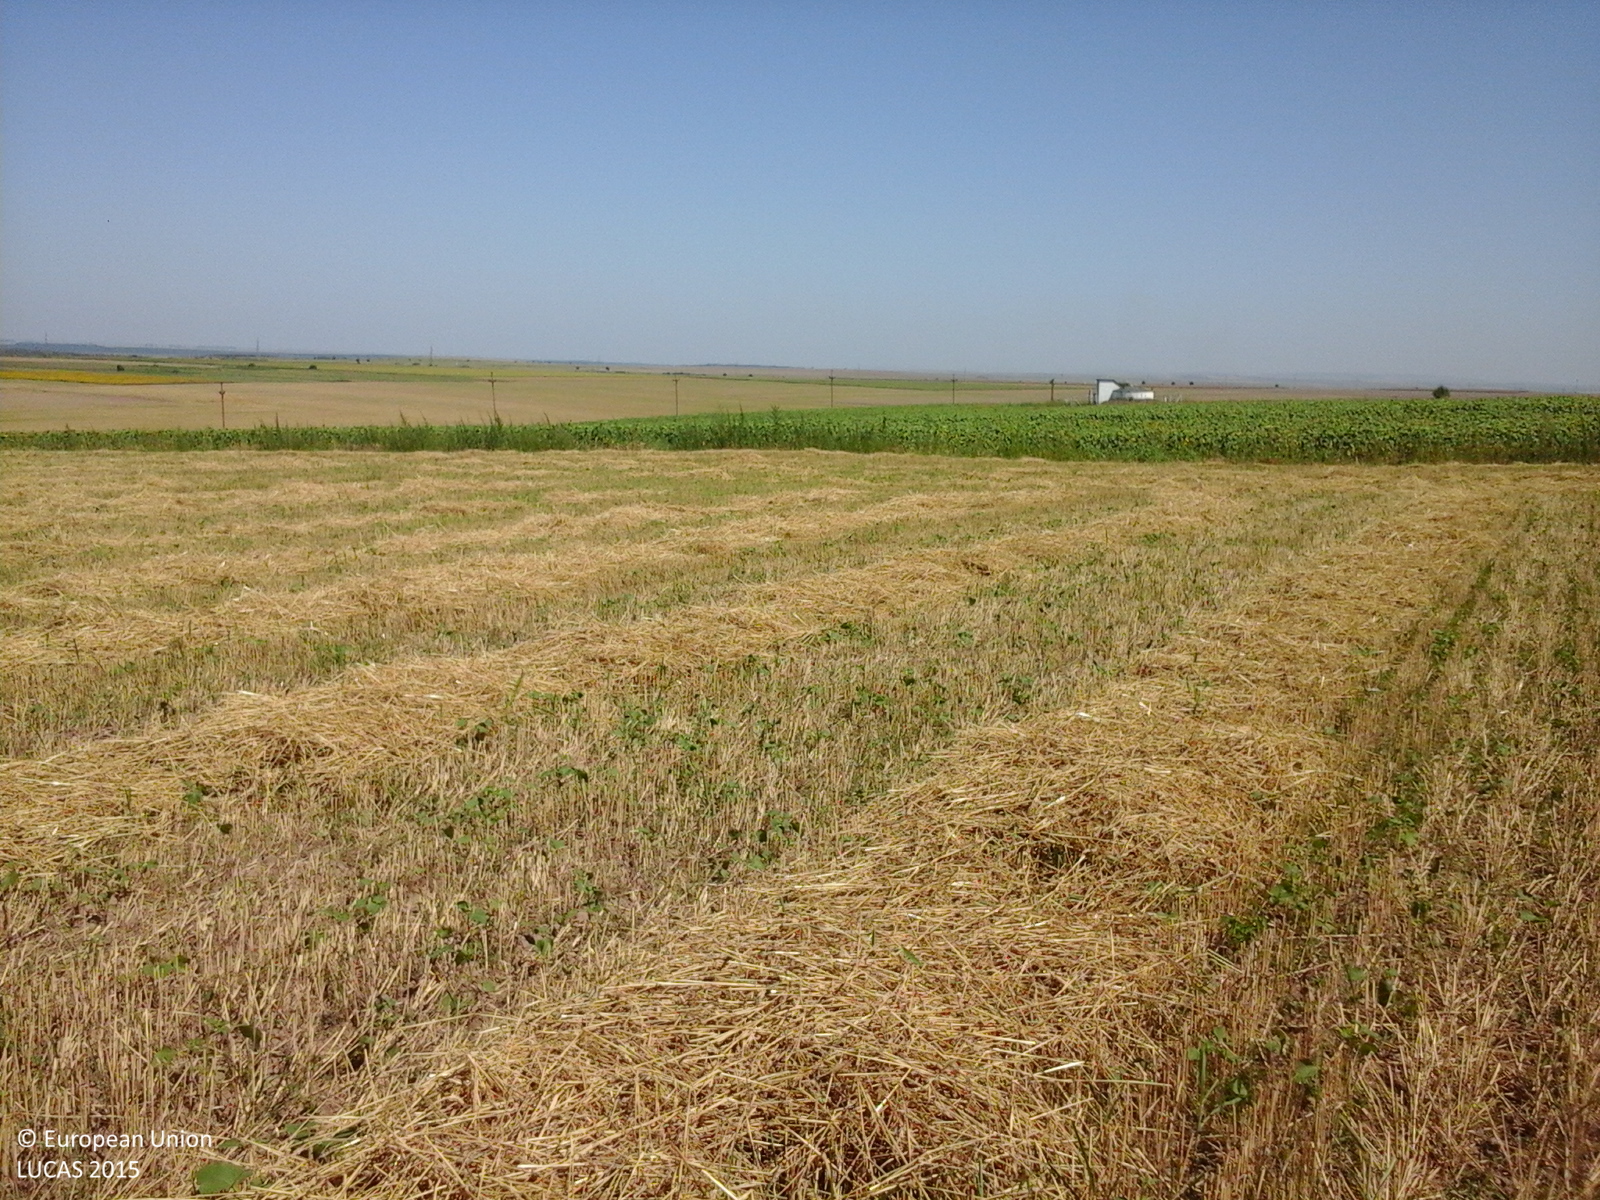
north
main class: Cropland
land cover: Common wheat
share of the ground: 50 - 75 %
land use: Agriculture (excluding fallow land and kitchen gardens)
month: August
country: RO
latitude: 44.6812
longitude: 28.0903
